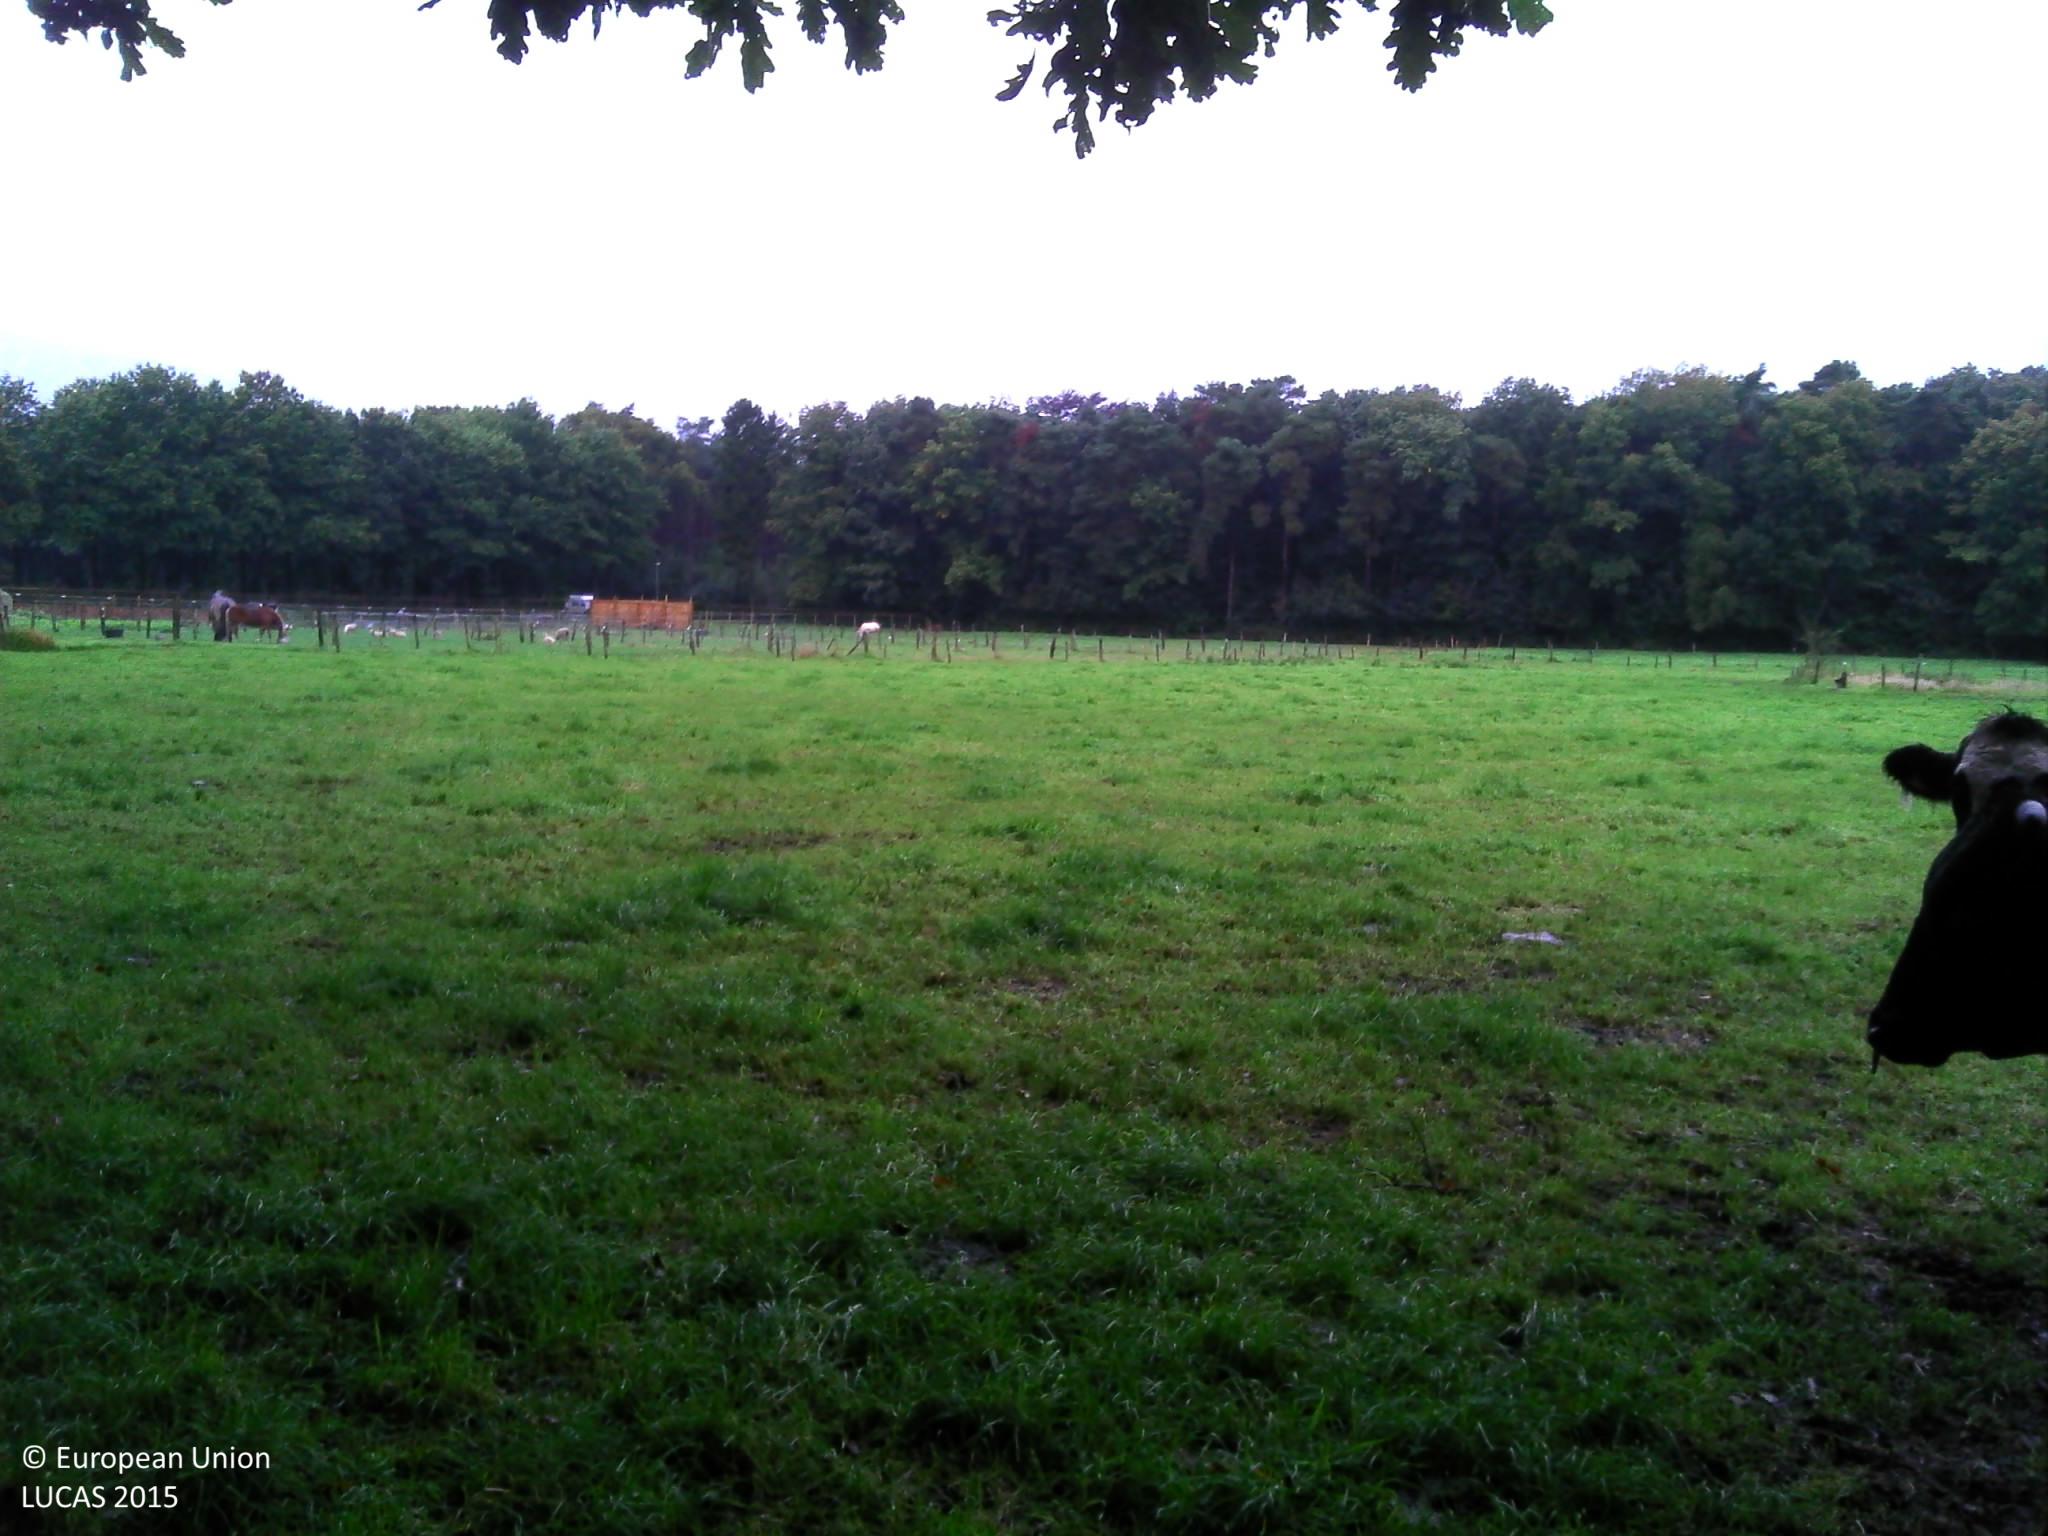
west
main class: Grassland
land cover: Grassland without tree/shrub cover
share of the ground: > 75 %
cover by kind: herbaceous plants 95 %, unconsolidated bare surface 5 %
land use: Agriculture (excluding fallow land and kitchen gardens)
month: September
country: BE
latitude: 51.2839
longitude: 4.6482
